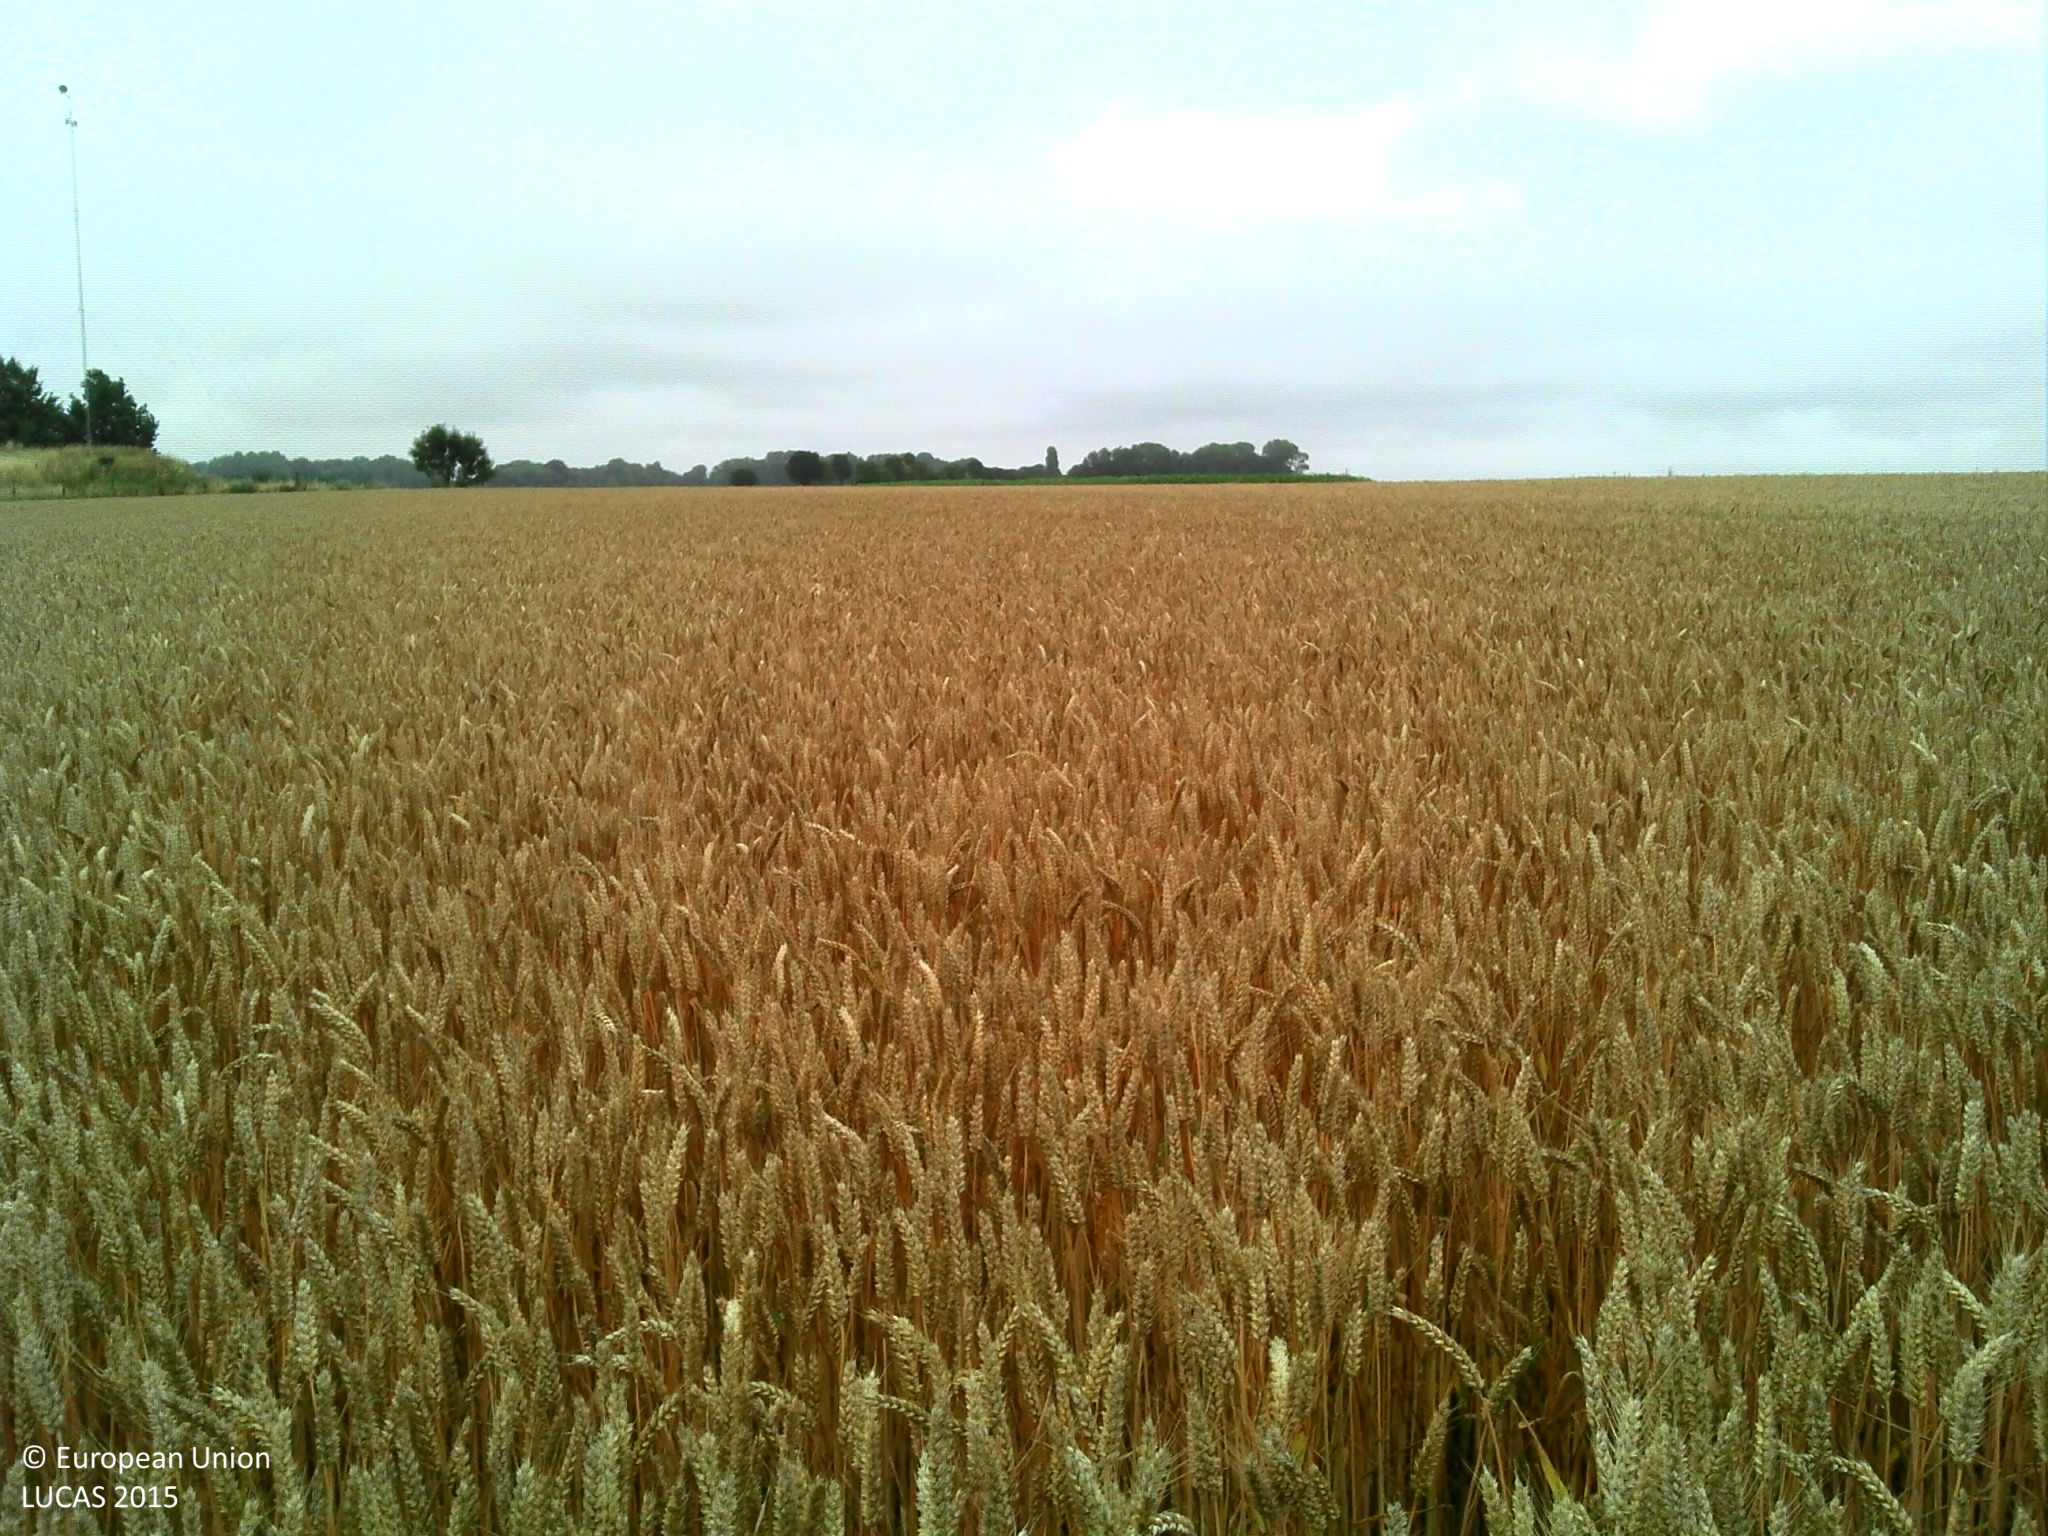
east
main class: Cropland
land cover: Common wheat
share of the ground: > 75 %
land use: Agriculture (excluding fallow land and kitchen gardens)
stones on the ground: < 10 %
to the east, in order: Common wheat; Grass margins; Ditches and canals; Grass margins; Paved roads, cycling and walking lanes; Grass margins; Ditches and canals; Grass margins; Maize
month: July
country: FR
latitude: 50.1538
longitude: 2.4997
